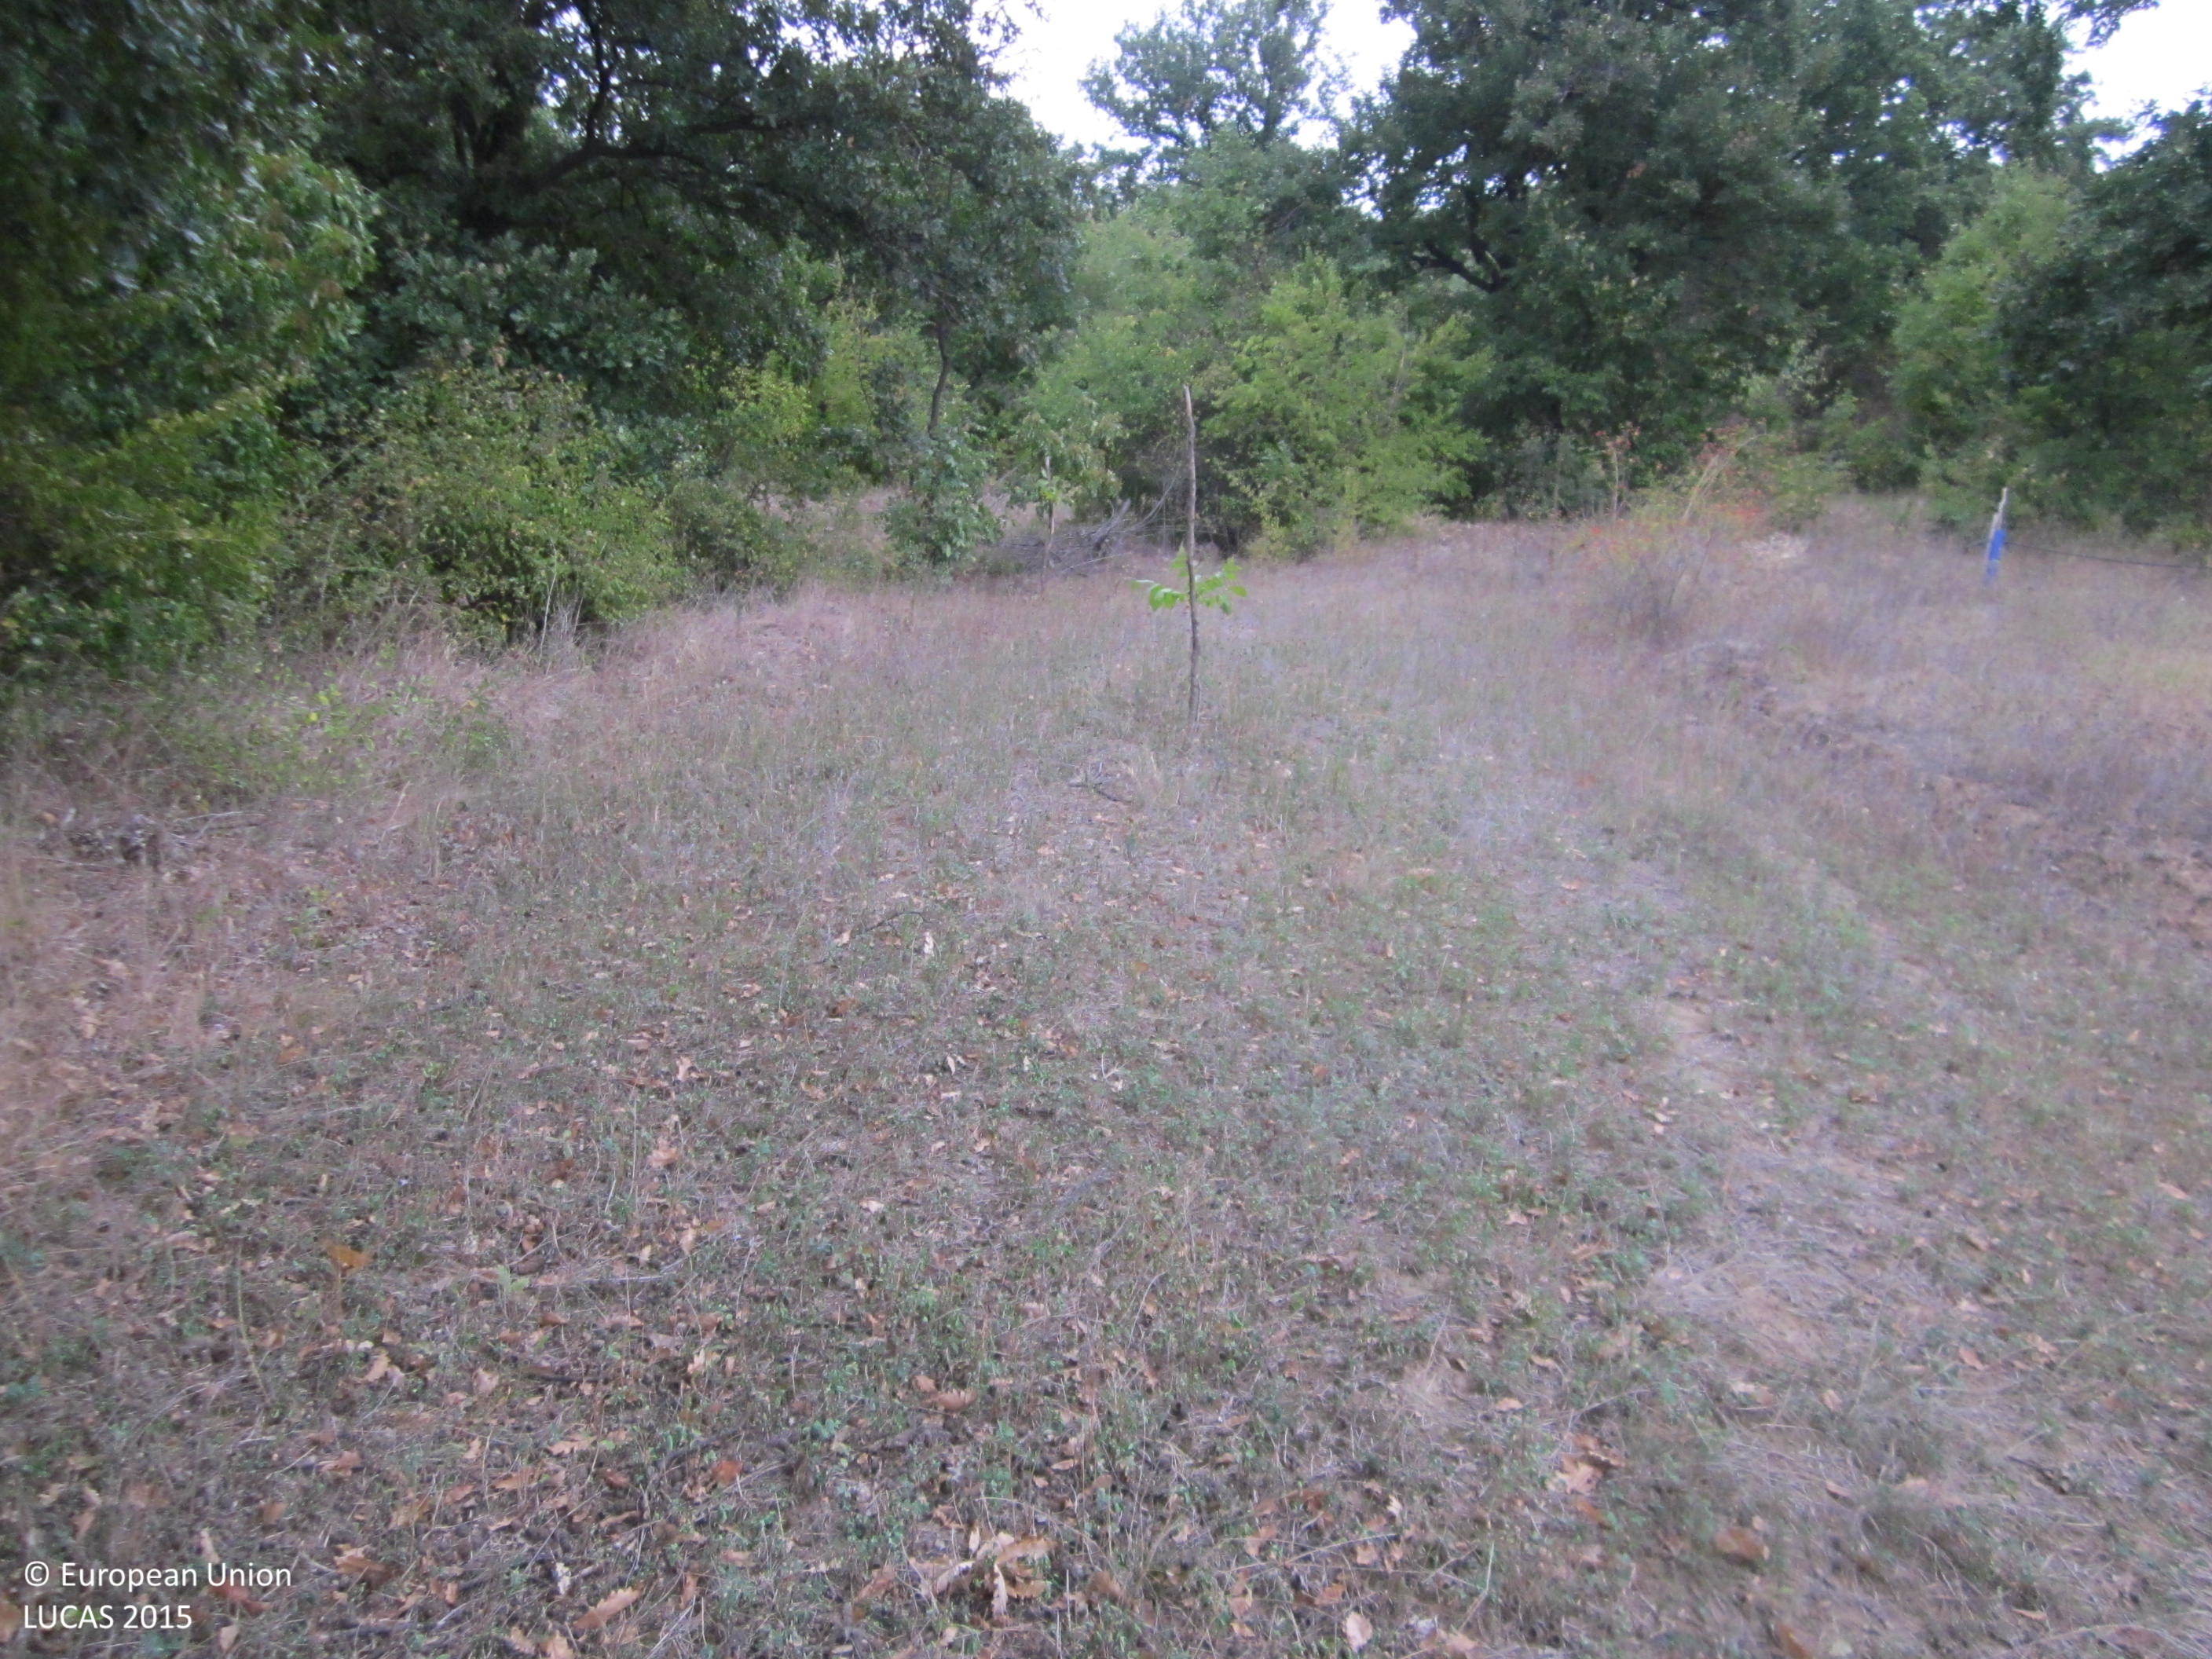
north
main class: Cropland
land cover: Nuts trees
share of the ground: 10 - 25 %
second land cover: Grassland without tree/shrub cover
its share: 25 - 50 %
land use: Agriculture (excluding fallow land and kitchen gardens)
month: September
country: BG
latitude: 42.8114
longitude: 27.3995
